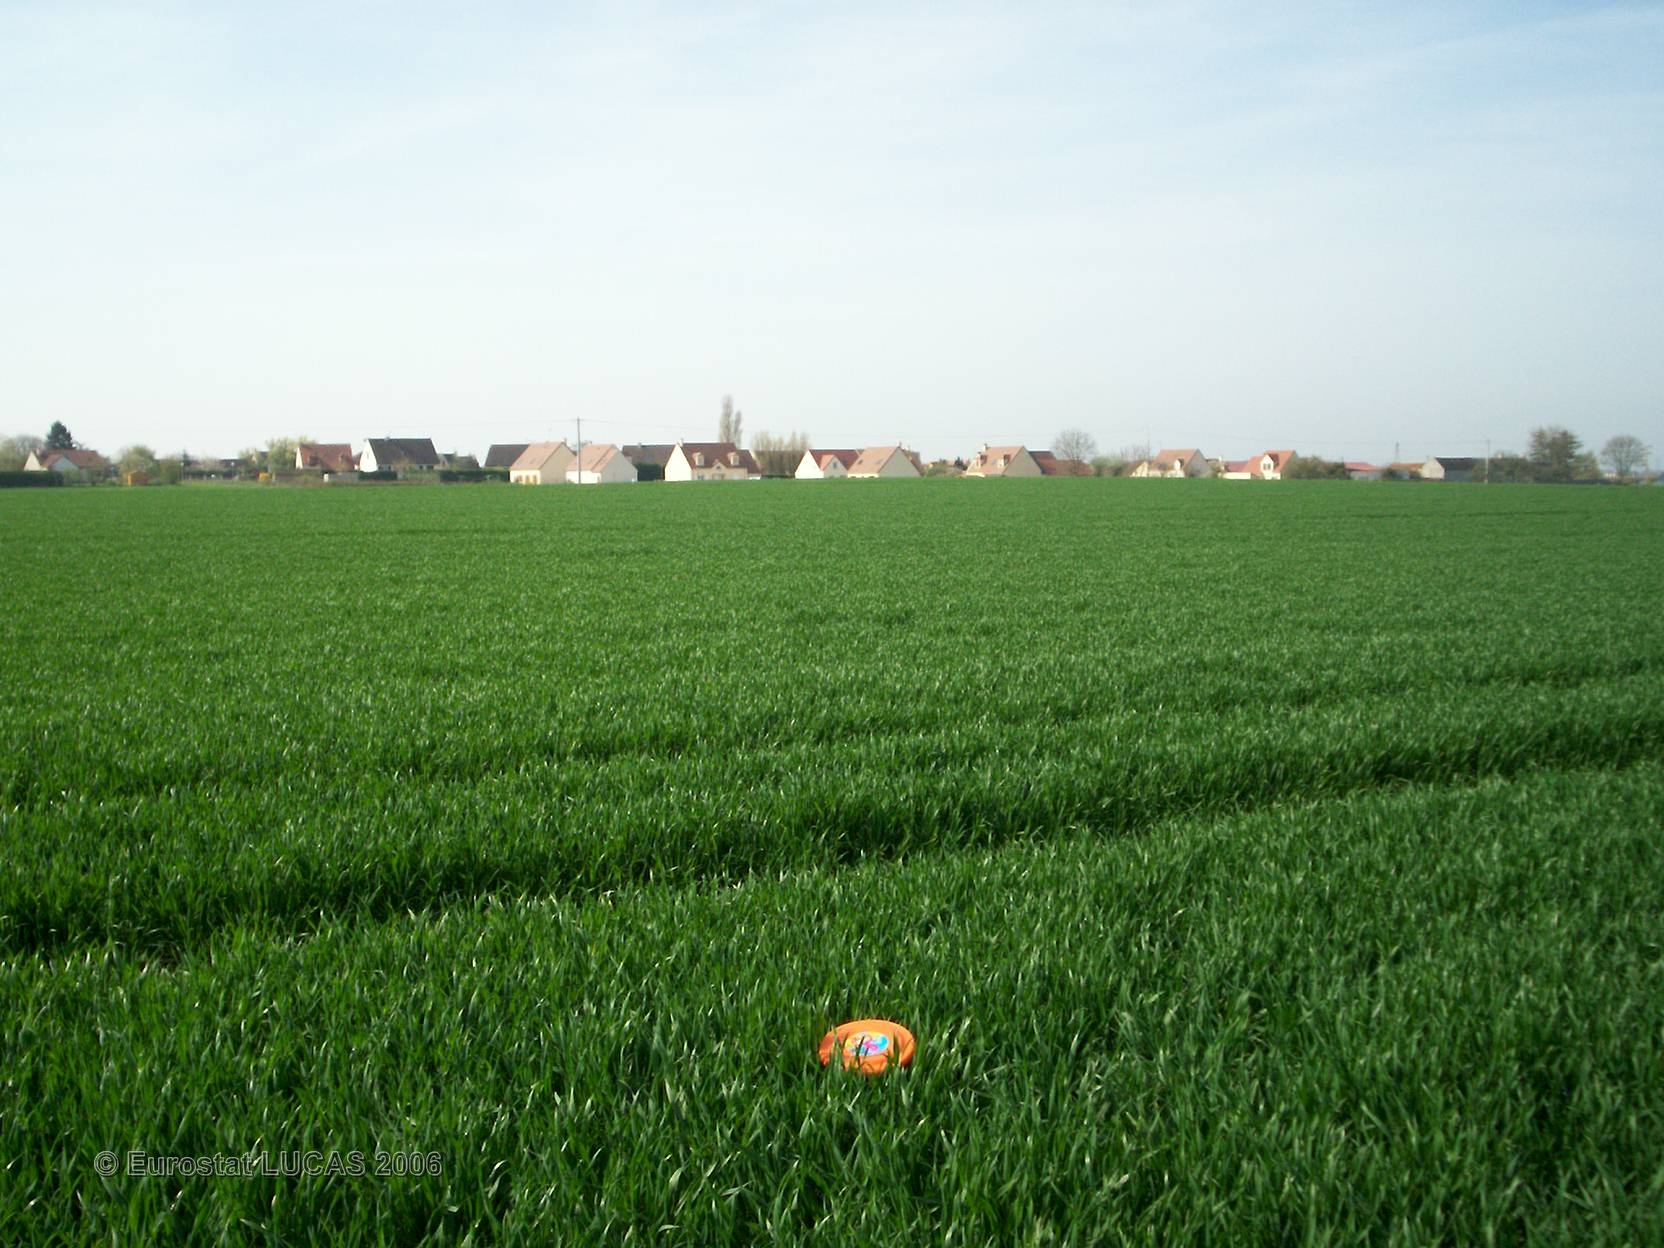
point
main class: Cropland
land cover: Barley
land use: Agriculture (excluding fallow land and kitchen gardens)
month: April
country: FR
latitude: 48.3920
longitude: 2.9015
